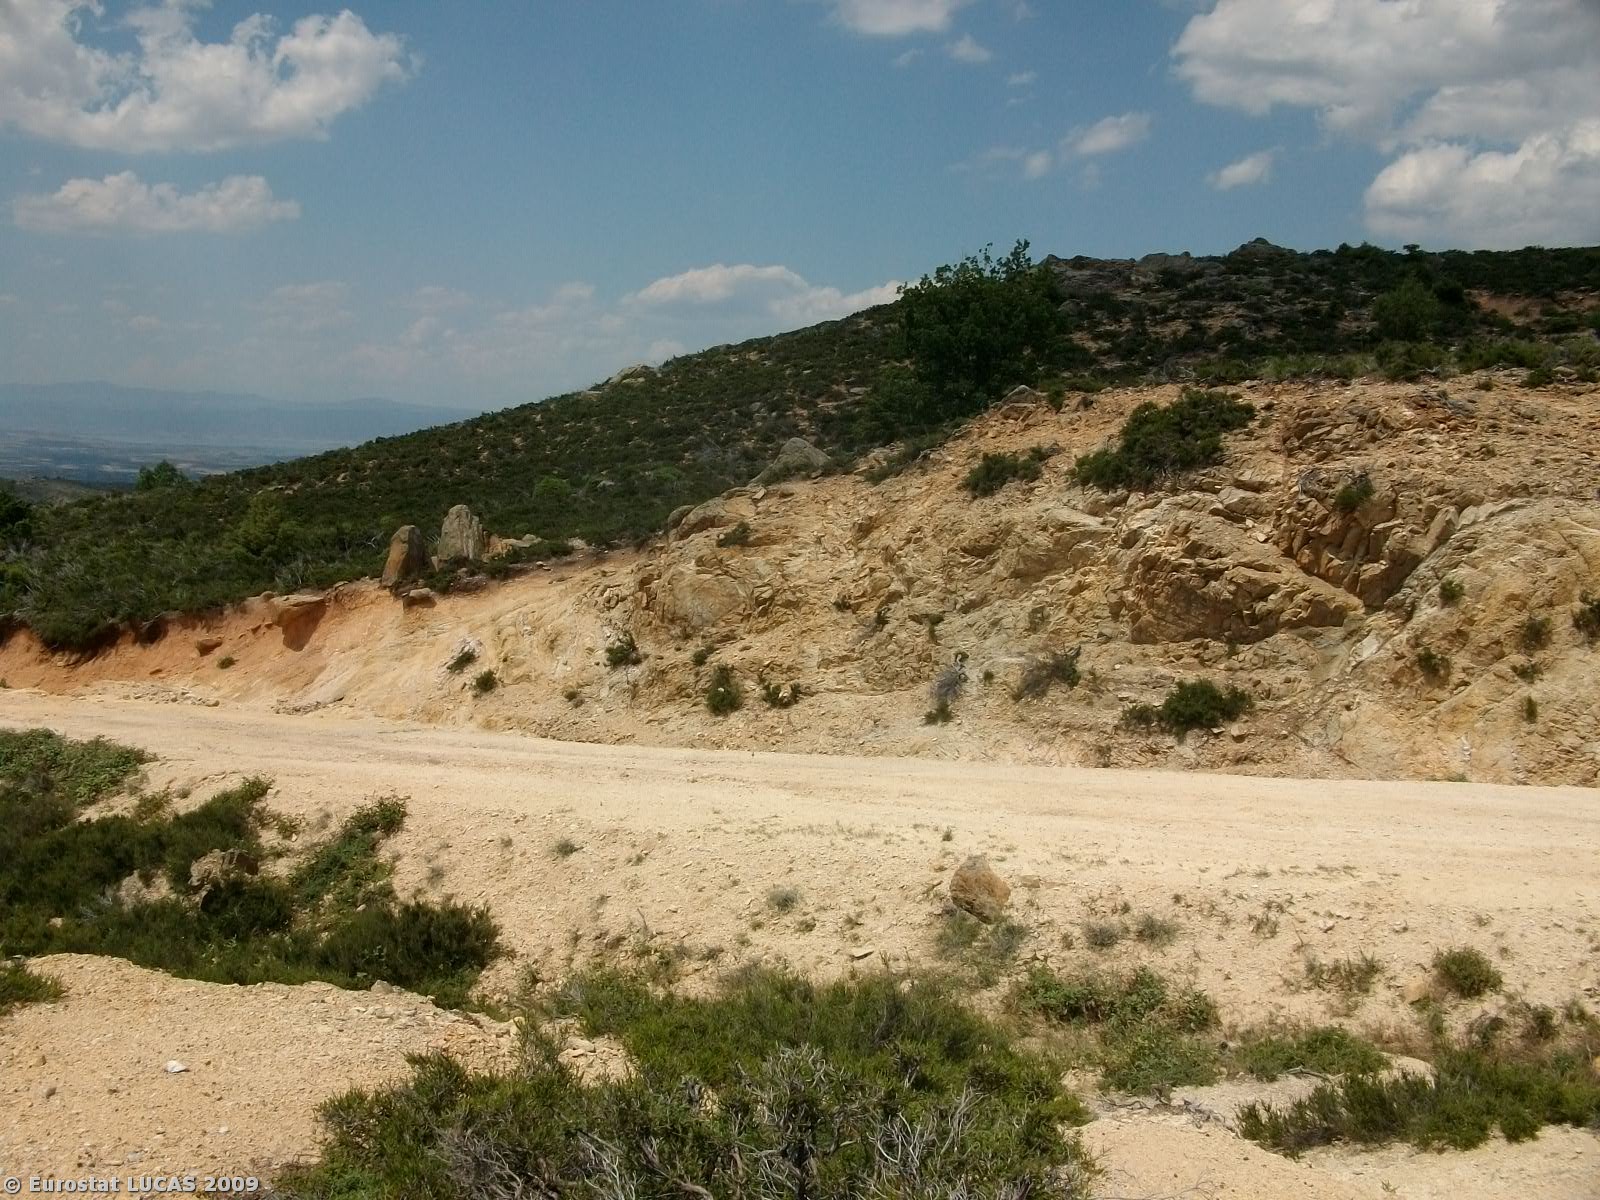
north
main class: Woodland
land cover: Mixed woodland
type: coniferous forest of the mediterranean region
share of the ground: > 75 %
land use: Nature reserves
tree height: > 5 m
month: July
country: GR
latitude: 40.4805
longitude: 23.5192
